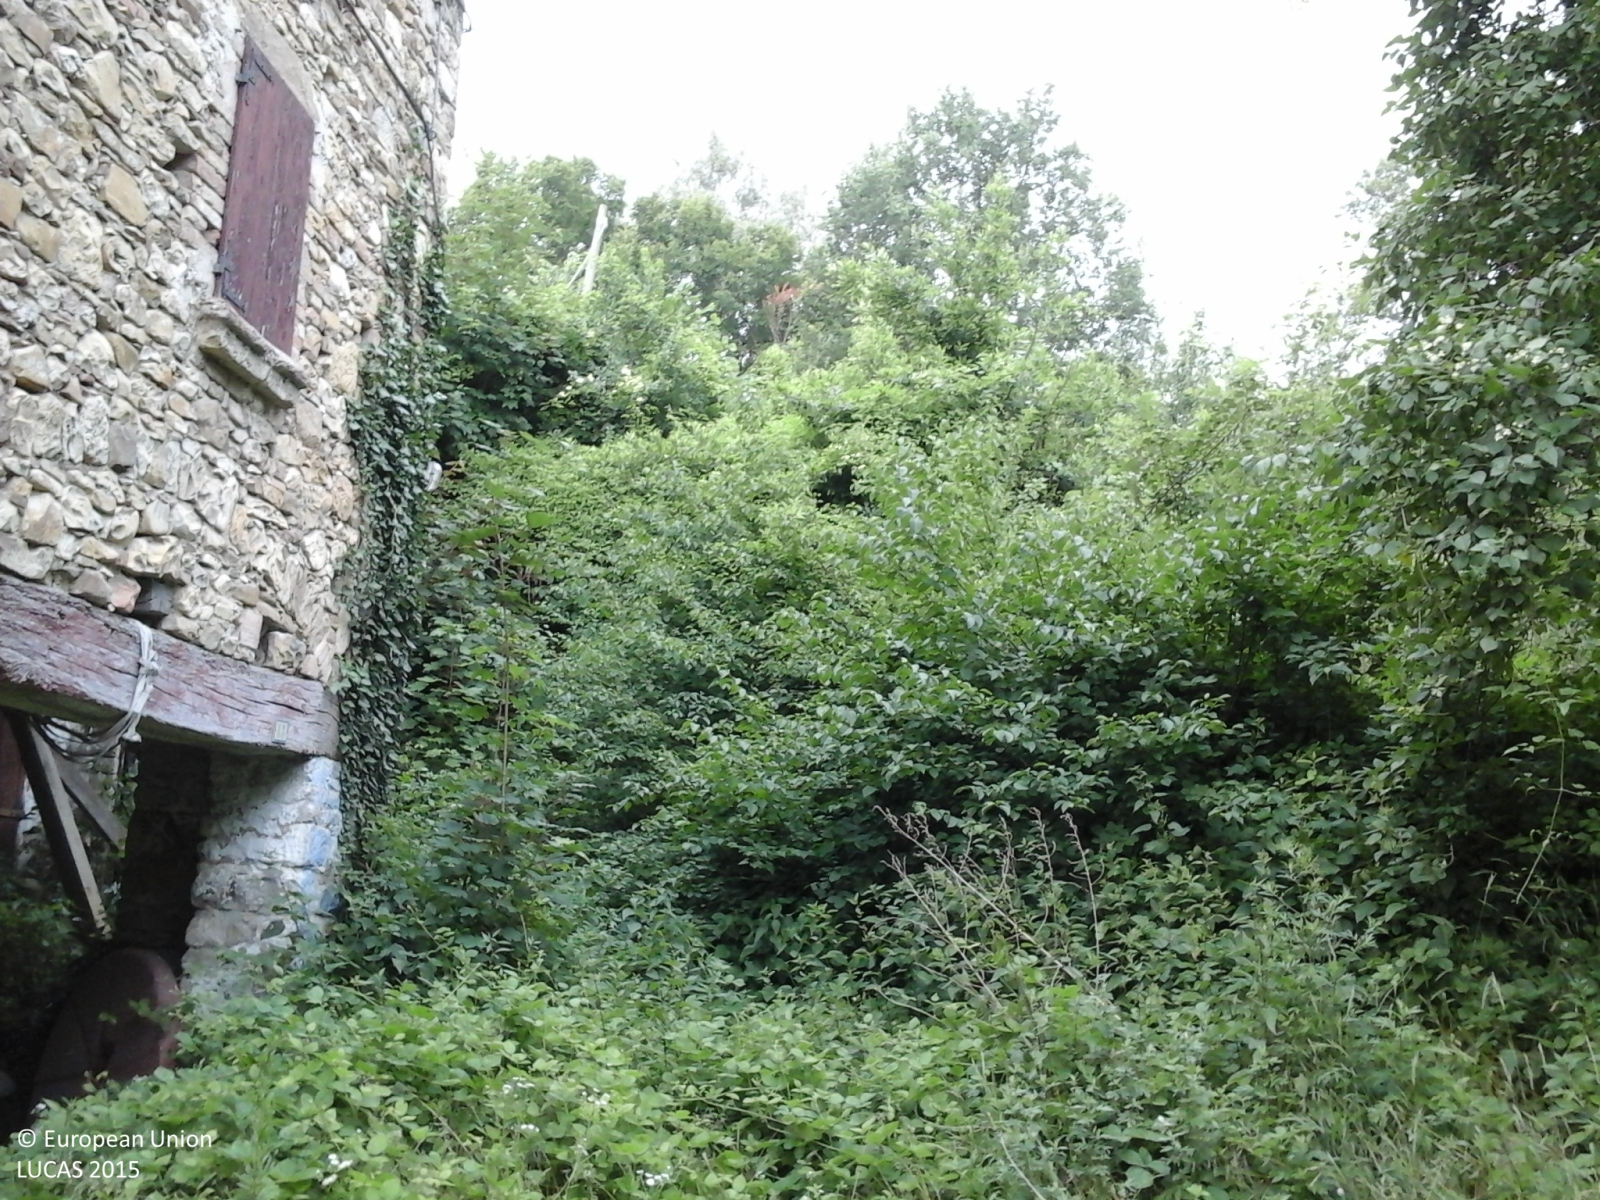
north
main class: Woodland
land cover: Broadleaved woodland
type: thermophilous deciduous forest
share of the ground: > 75 %
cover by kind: broadleaved forest trees 80 %, shrubs 20 %
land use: Forestry
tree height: > 5 m
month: June
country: IT
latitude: 44.8194
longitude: 9.9117
